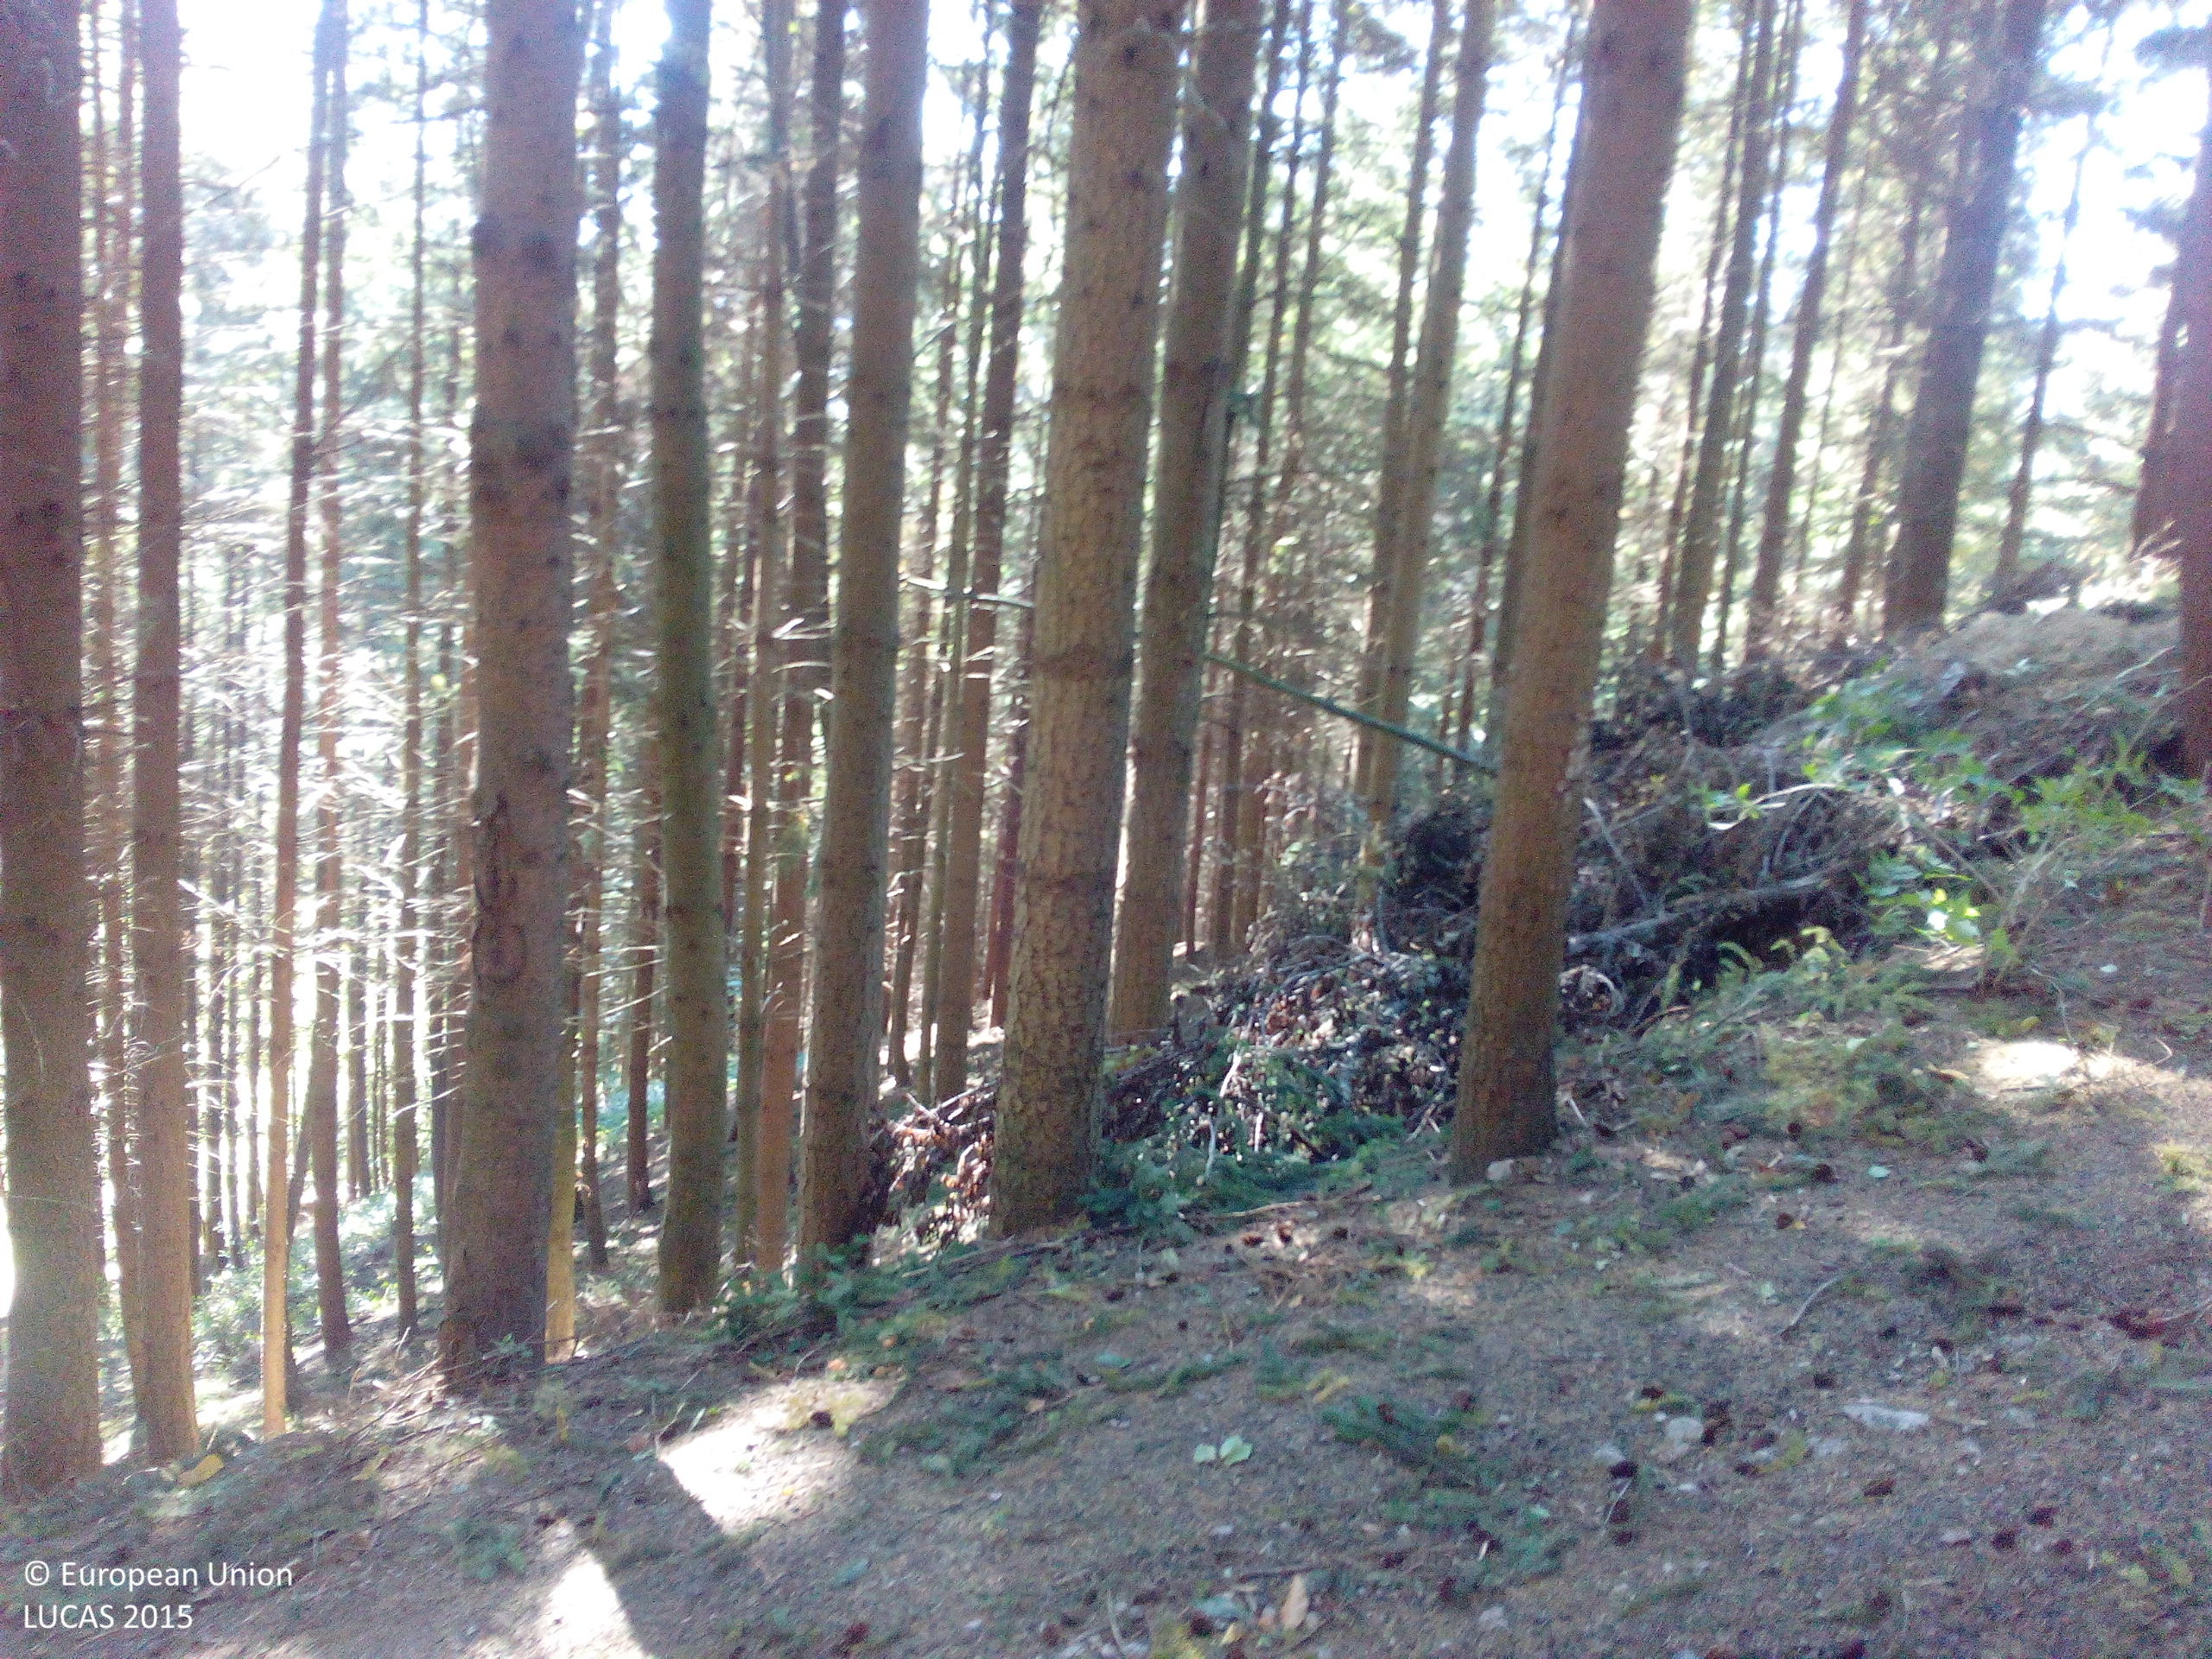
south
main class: Woodland
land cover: Spruce dominated coniferous woodland
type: hemiboreal forest and nemoral coniferous forest and mixed broadleaved-coniferous forest
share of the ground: > 75 %
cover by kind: coniferous forest trees 95 %, shrubs 5 %
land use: Forestry
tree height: > 5 m
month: September
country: DE
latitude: 48.5504
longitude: 8.1719
